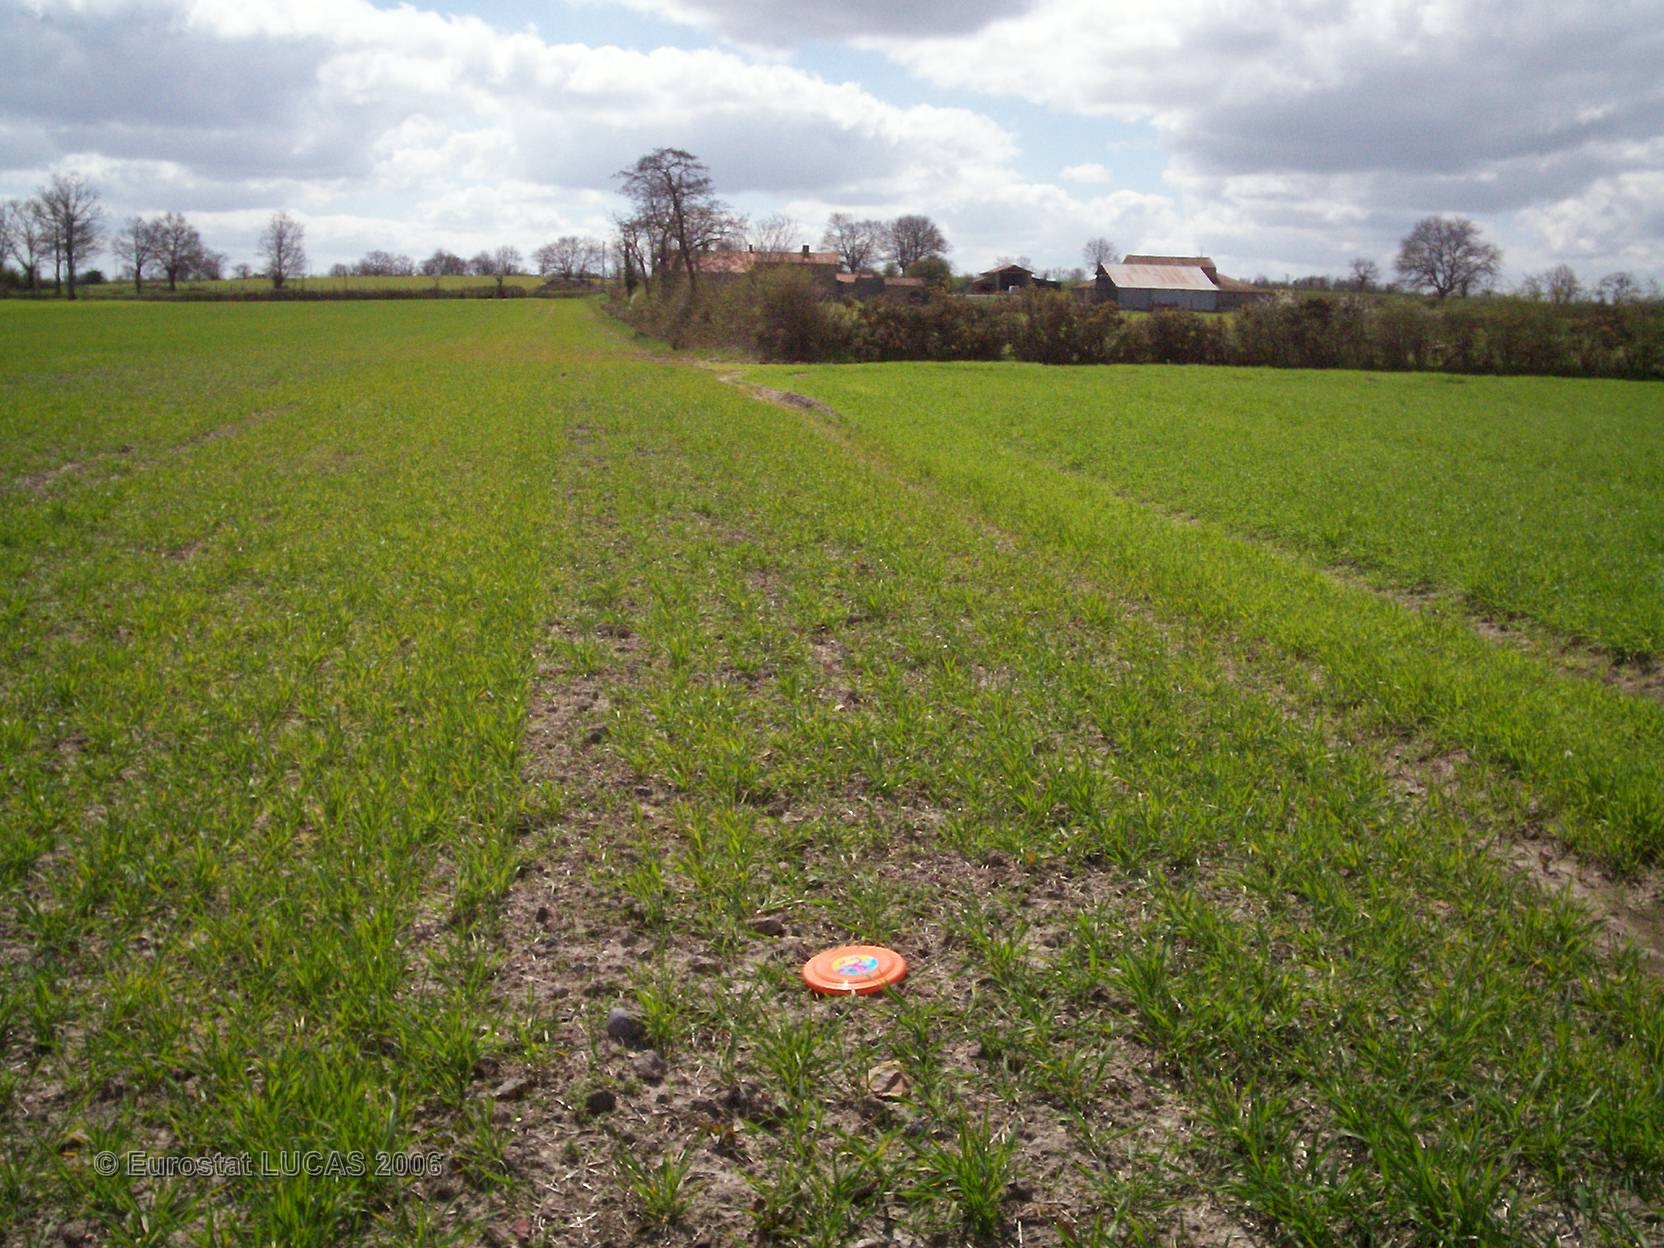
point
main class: Cropland
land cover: Barley
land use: Agriculture (excluding fallow land and kitchen gardens)
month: April
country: FR
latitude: 46.7776
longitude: -0.3070
